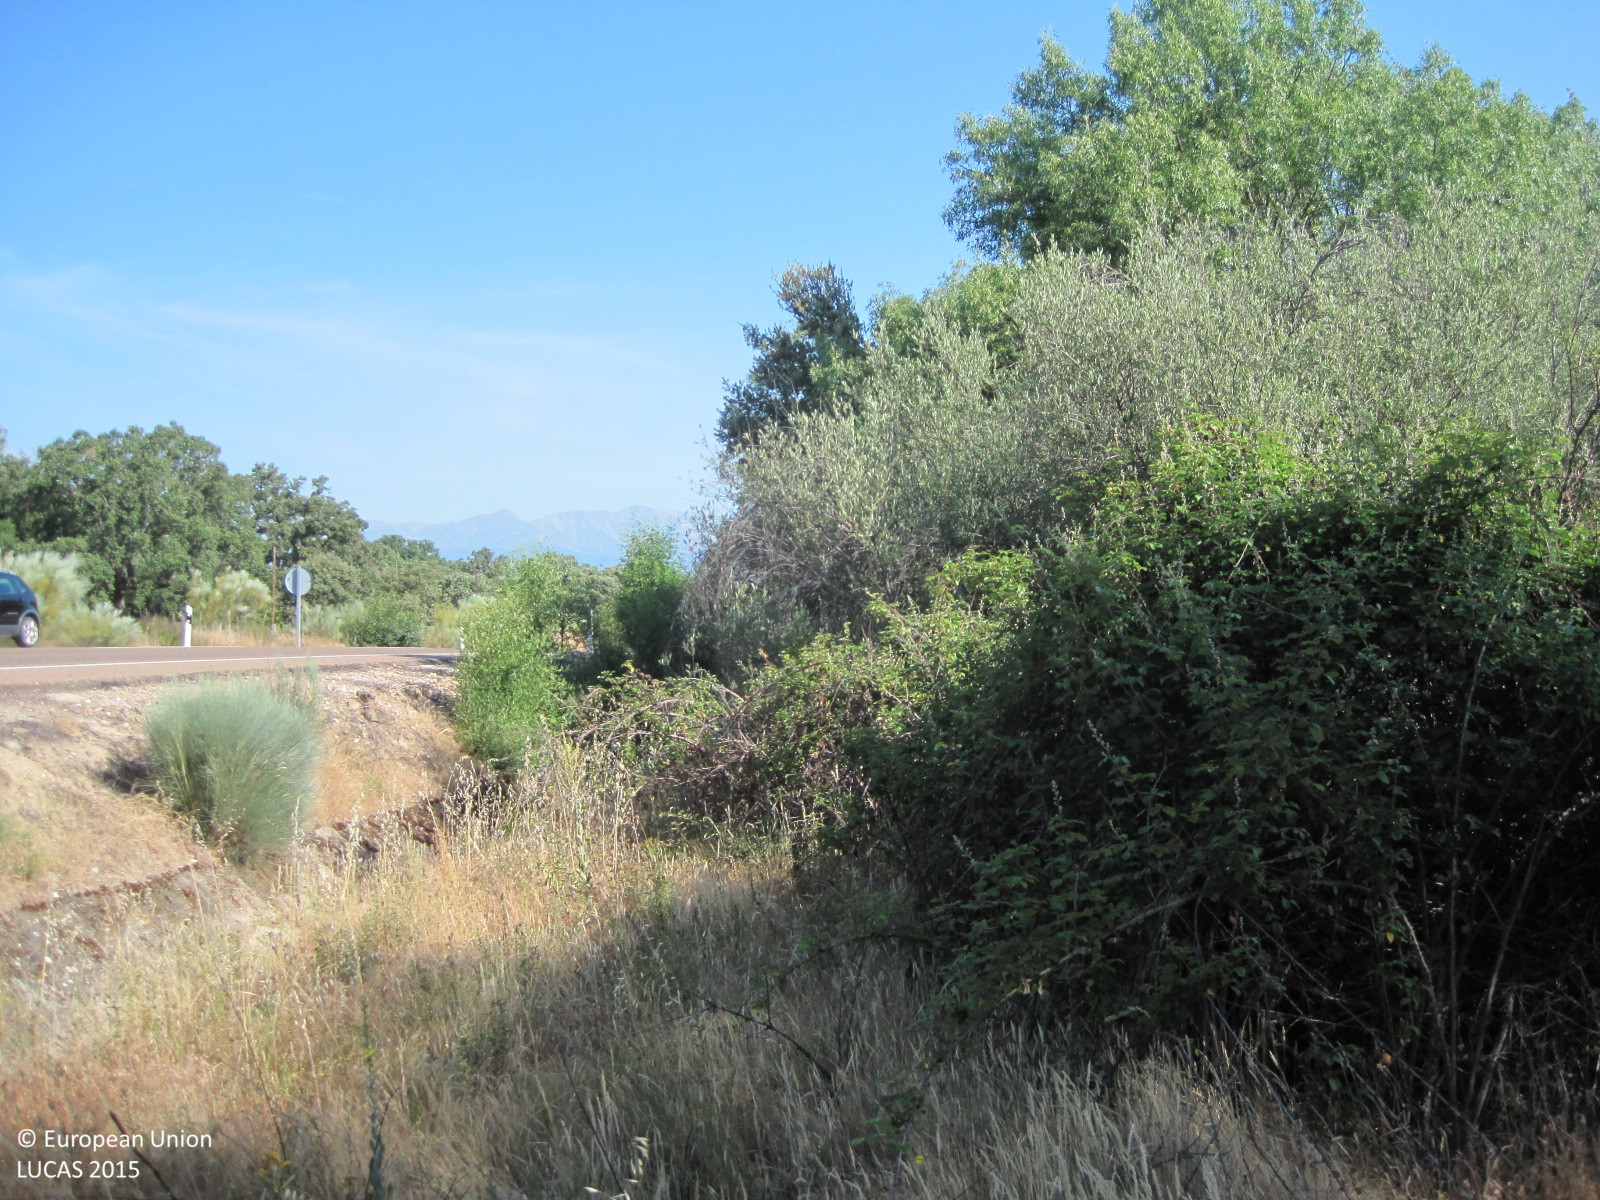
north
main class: Woodland
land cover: Broadleaved woodland
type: broadleaved evergreen forest
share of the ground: 25 - 50 %
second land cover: Grassland without tree/shrub cover
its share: 50 - 75 %
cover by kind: herbaceous plants 55 %, broadleaved forest trees 45 %
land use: Forestry
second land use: Agriculture (excluding fallow land and kitchen gardens)
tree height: > 5 m
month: June
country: ES
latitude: 40.0441
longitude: -4.9957
